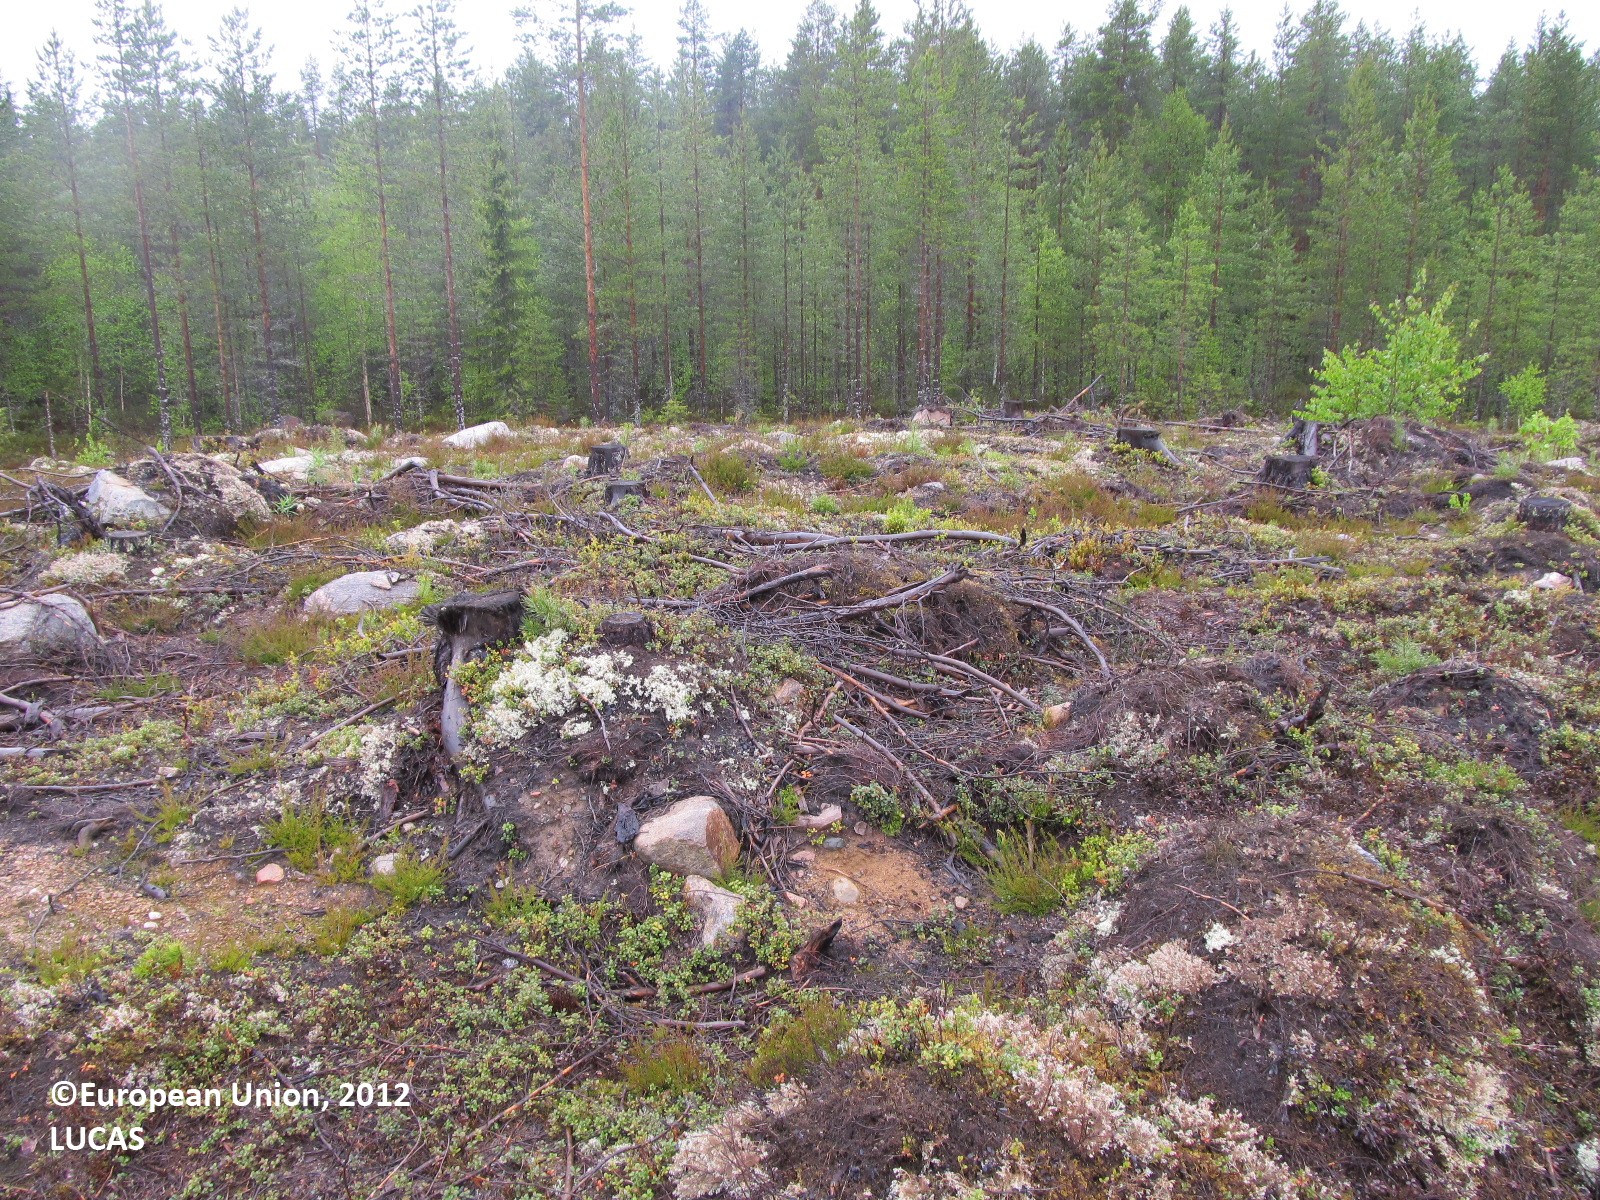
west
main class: Shrubland
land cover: Shrubland without tree cover
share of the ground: 50 - 75 %
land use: Forestry
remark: Clear cut
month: June
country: FI
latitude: 63.3061
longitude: 29.1511
